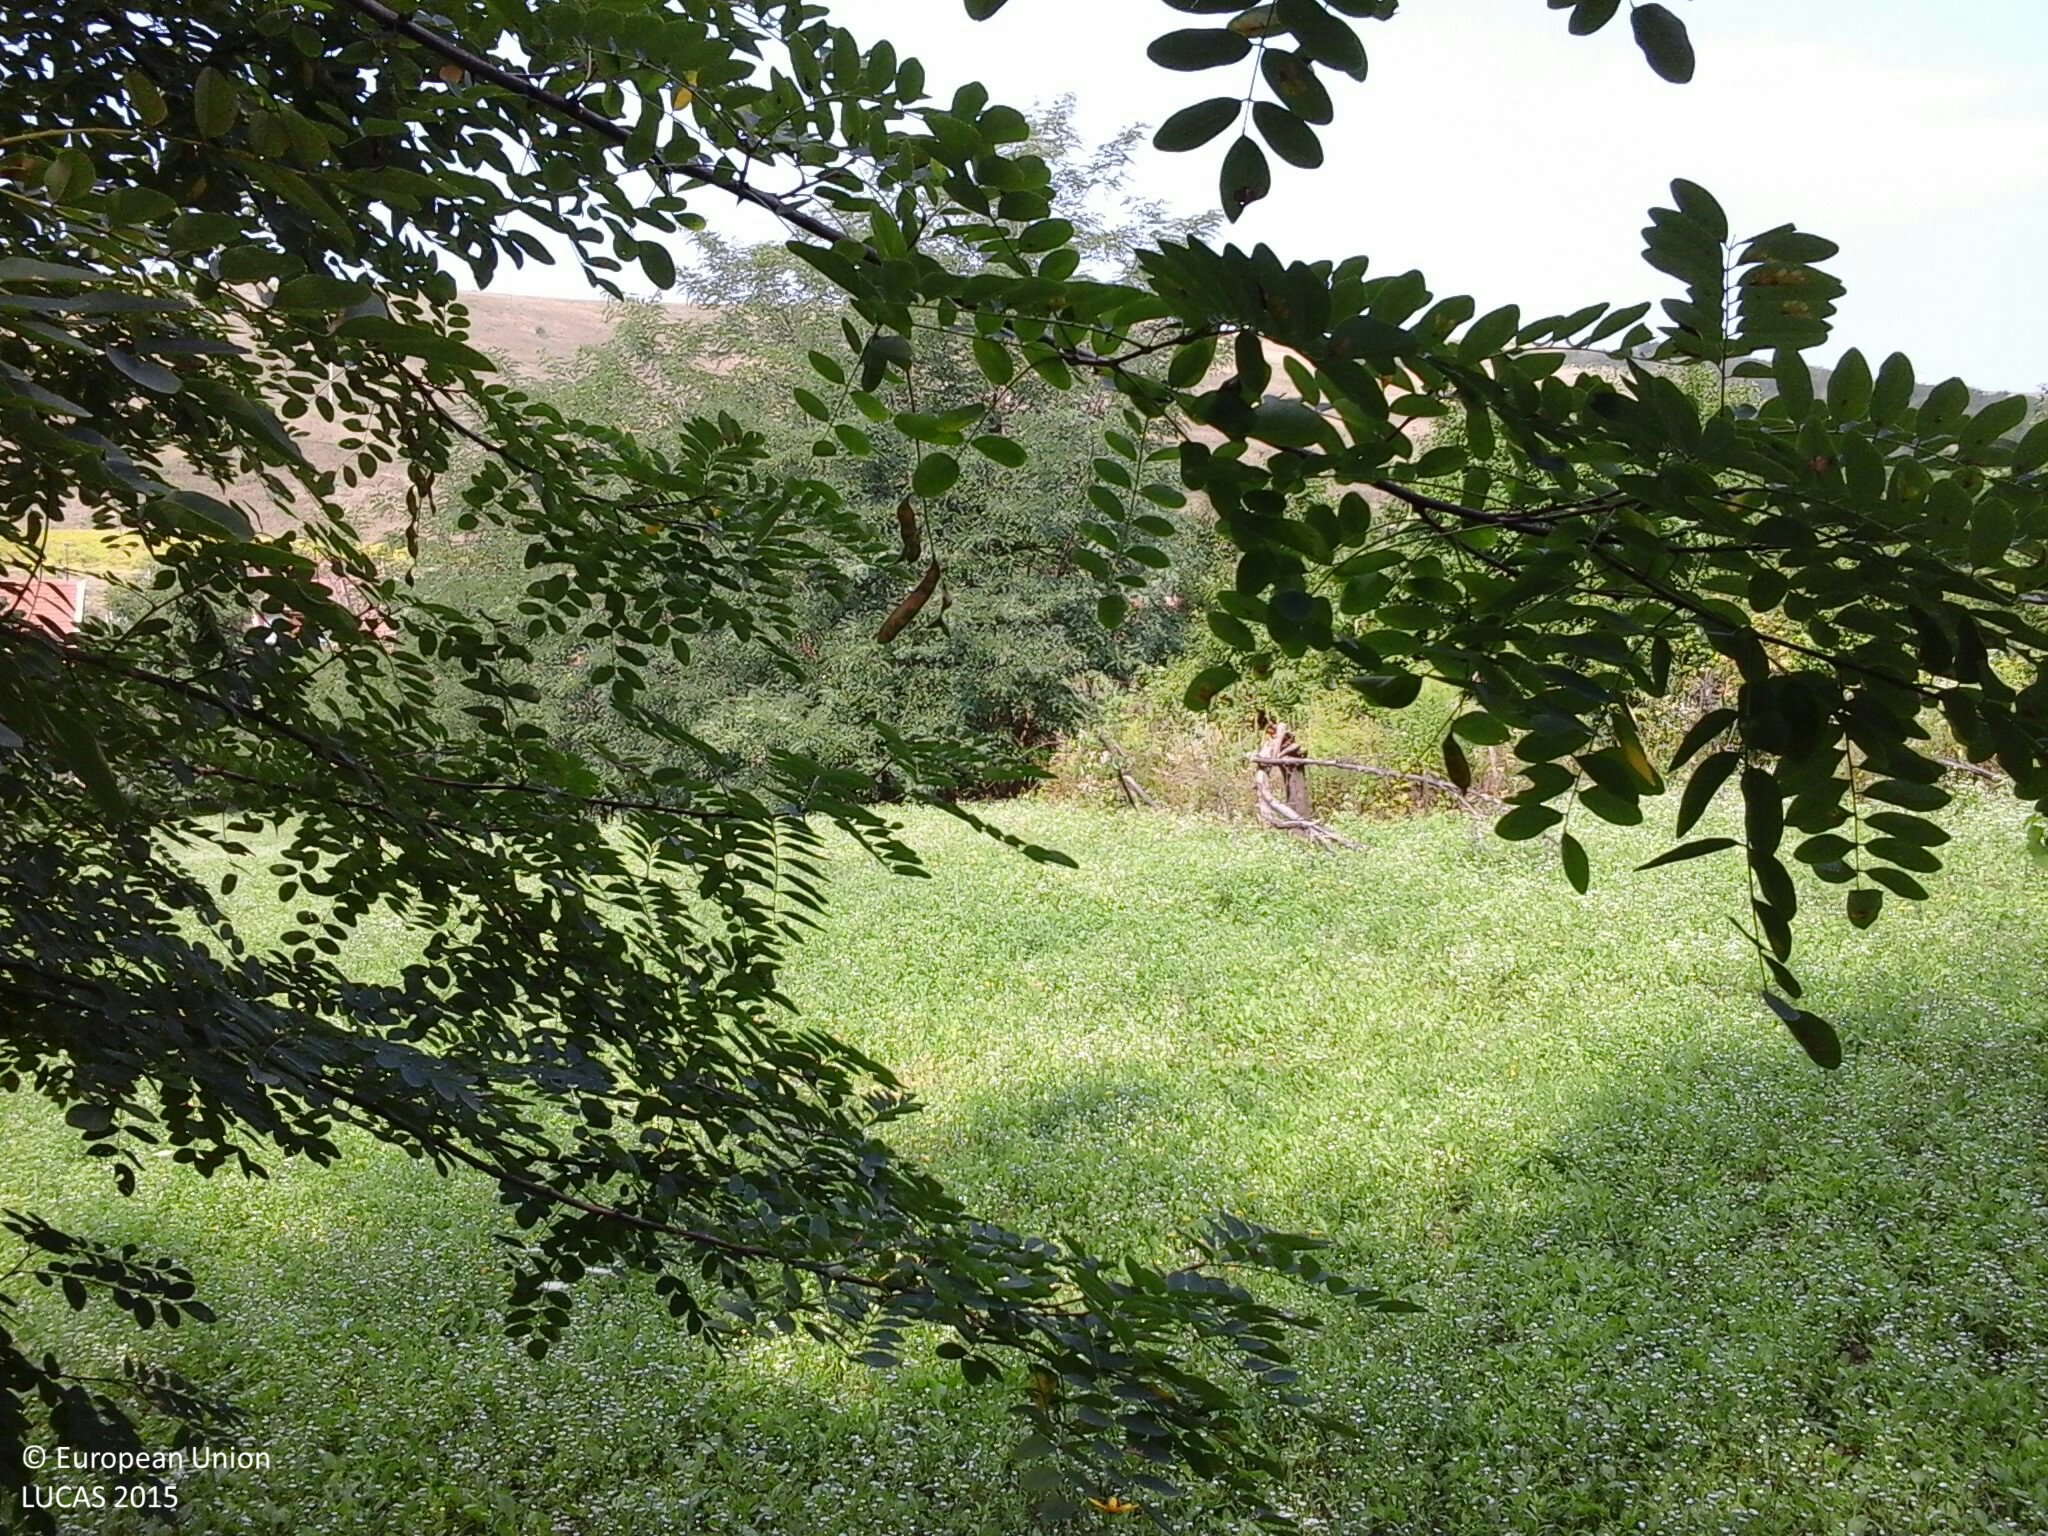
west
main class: Shrubland
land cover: Shrubland with sparse tree cover
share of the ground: > 75 %
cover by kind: herbaceous plants 75 %, shrubs 20 %, broadleaved forest trees 5 %
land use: Agriculture (excluding fallow land and kitchen gardens)
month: August
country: HU
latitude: 48.3028
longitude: 20.6731
